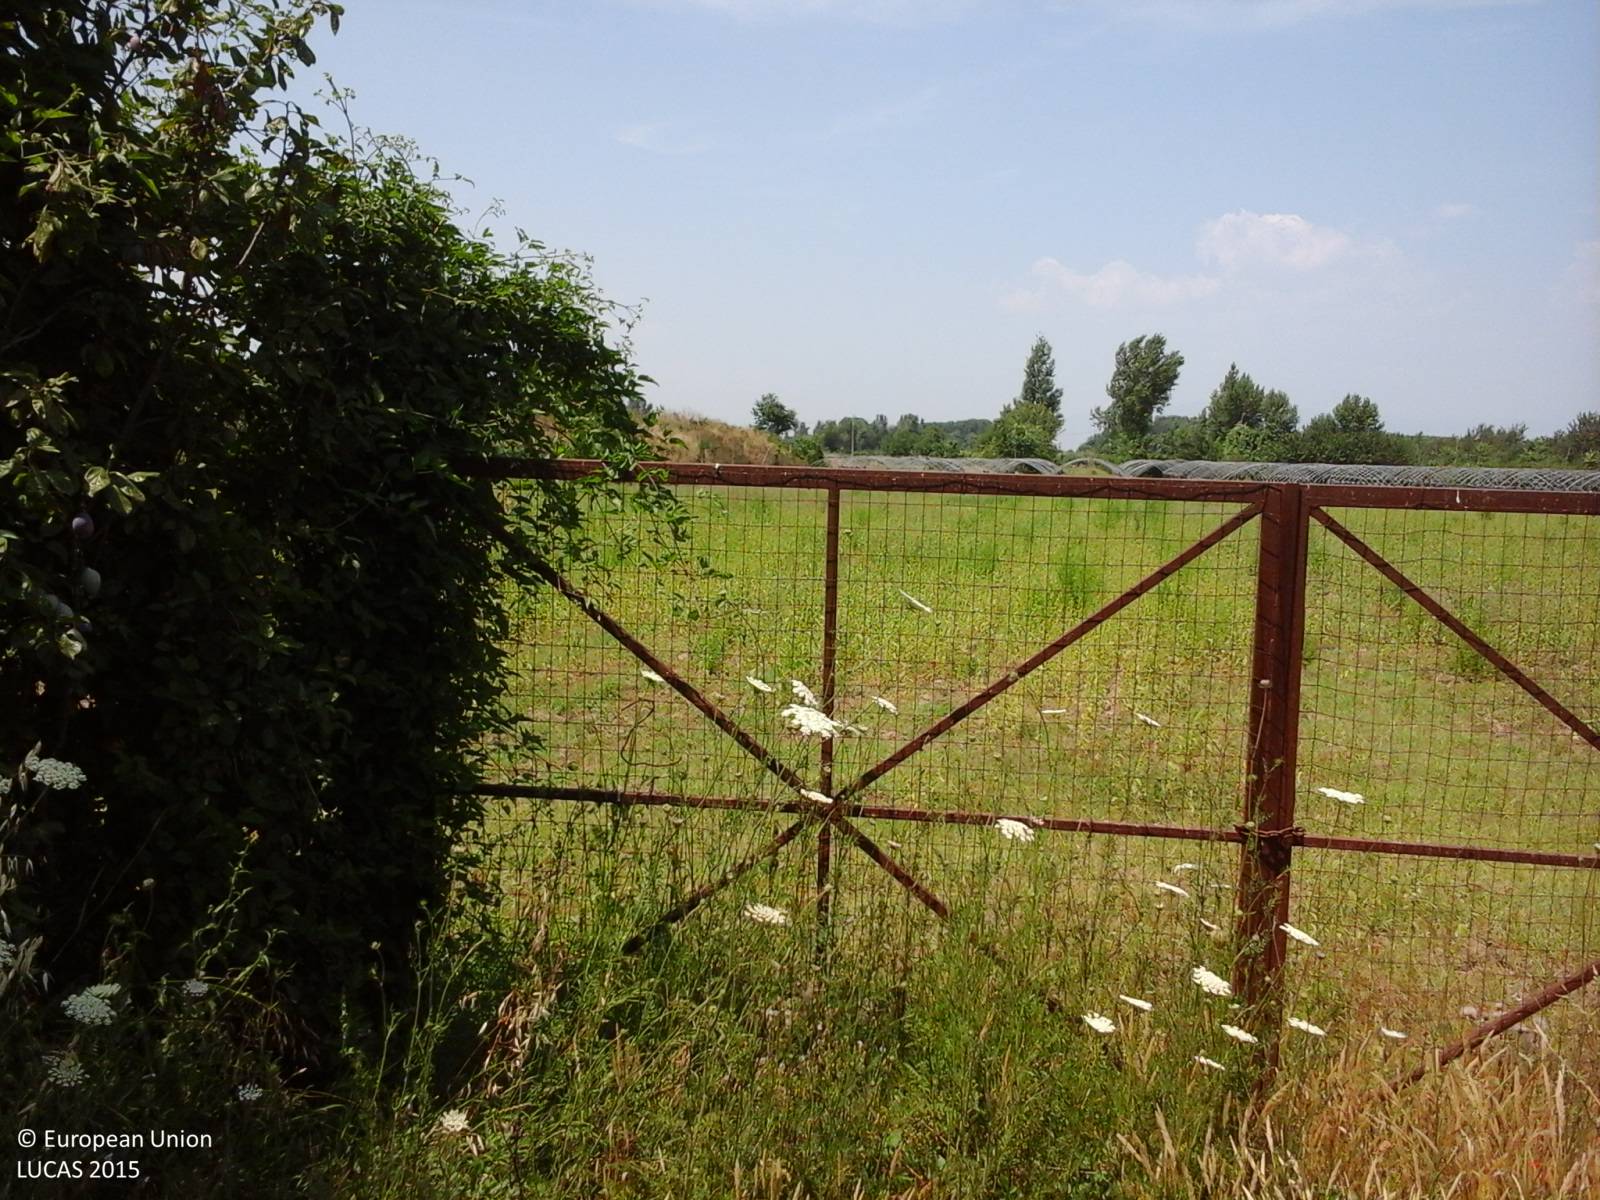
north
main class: Grassland
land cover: Spontaneously vegetated surfaces
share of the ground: > 75 %
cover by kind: herbaceous plants 100 %
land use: Agriculture (excluding fallow land and kitchen gardens)
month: July
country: IT
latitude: 40.9764
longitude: 14.1543
